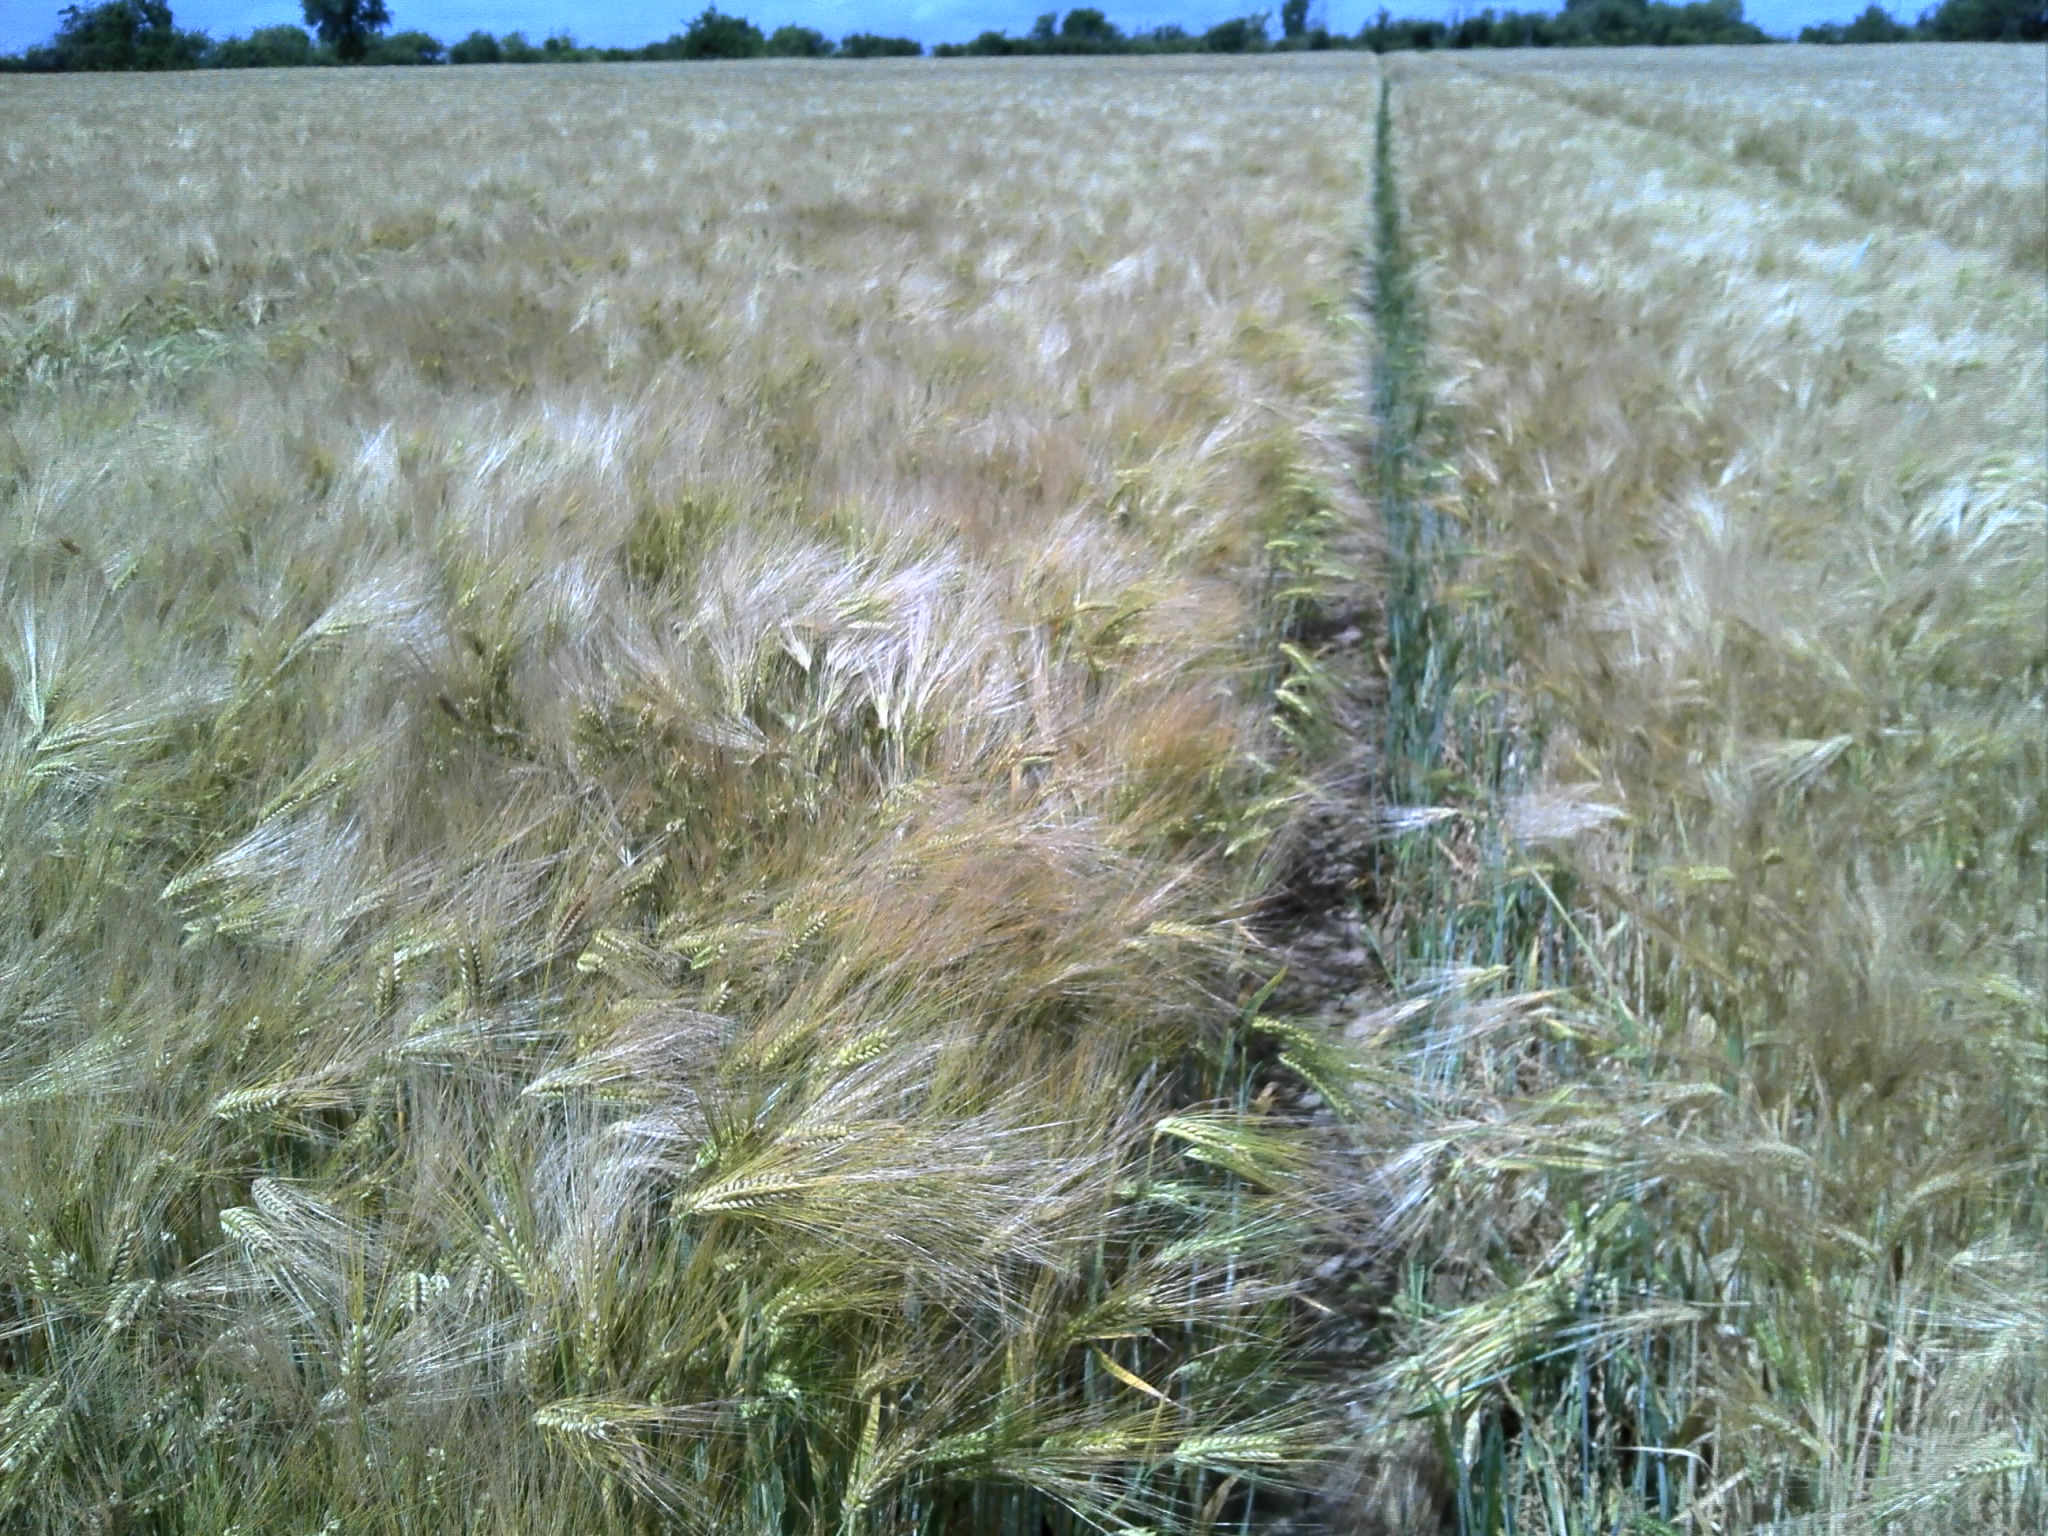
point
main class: Cropland
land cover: Barley
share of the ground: > 75 %
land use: Agriculture (excluding fallow land and kitchen gardens)
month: June
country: FR
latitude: 46.6627
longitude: 1.4809
